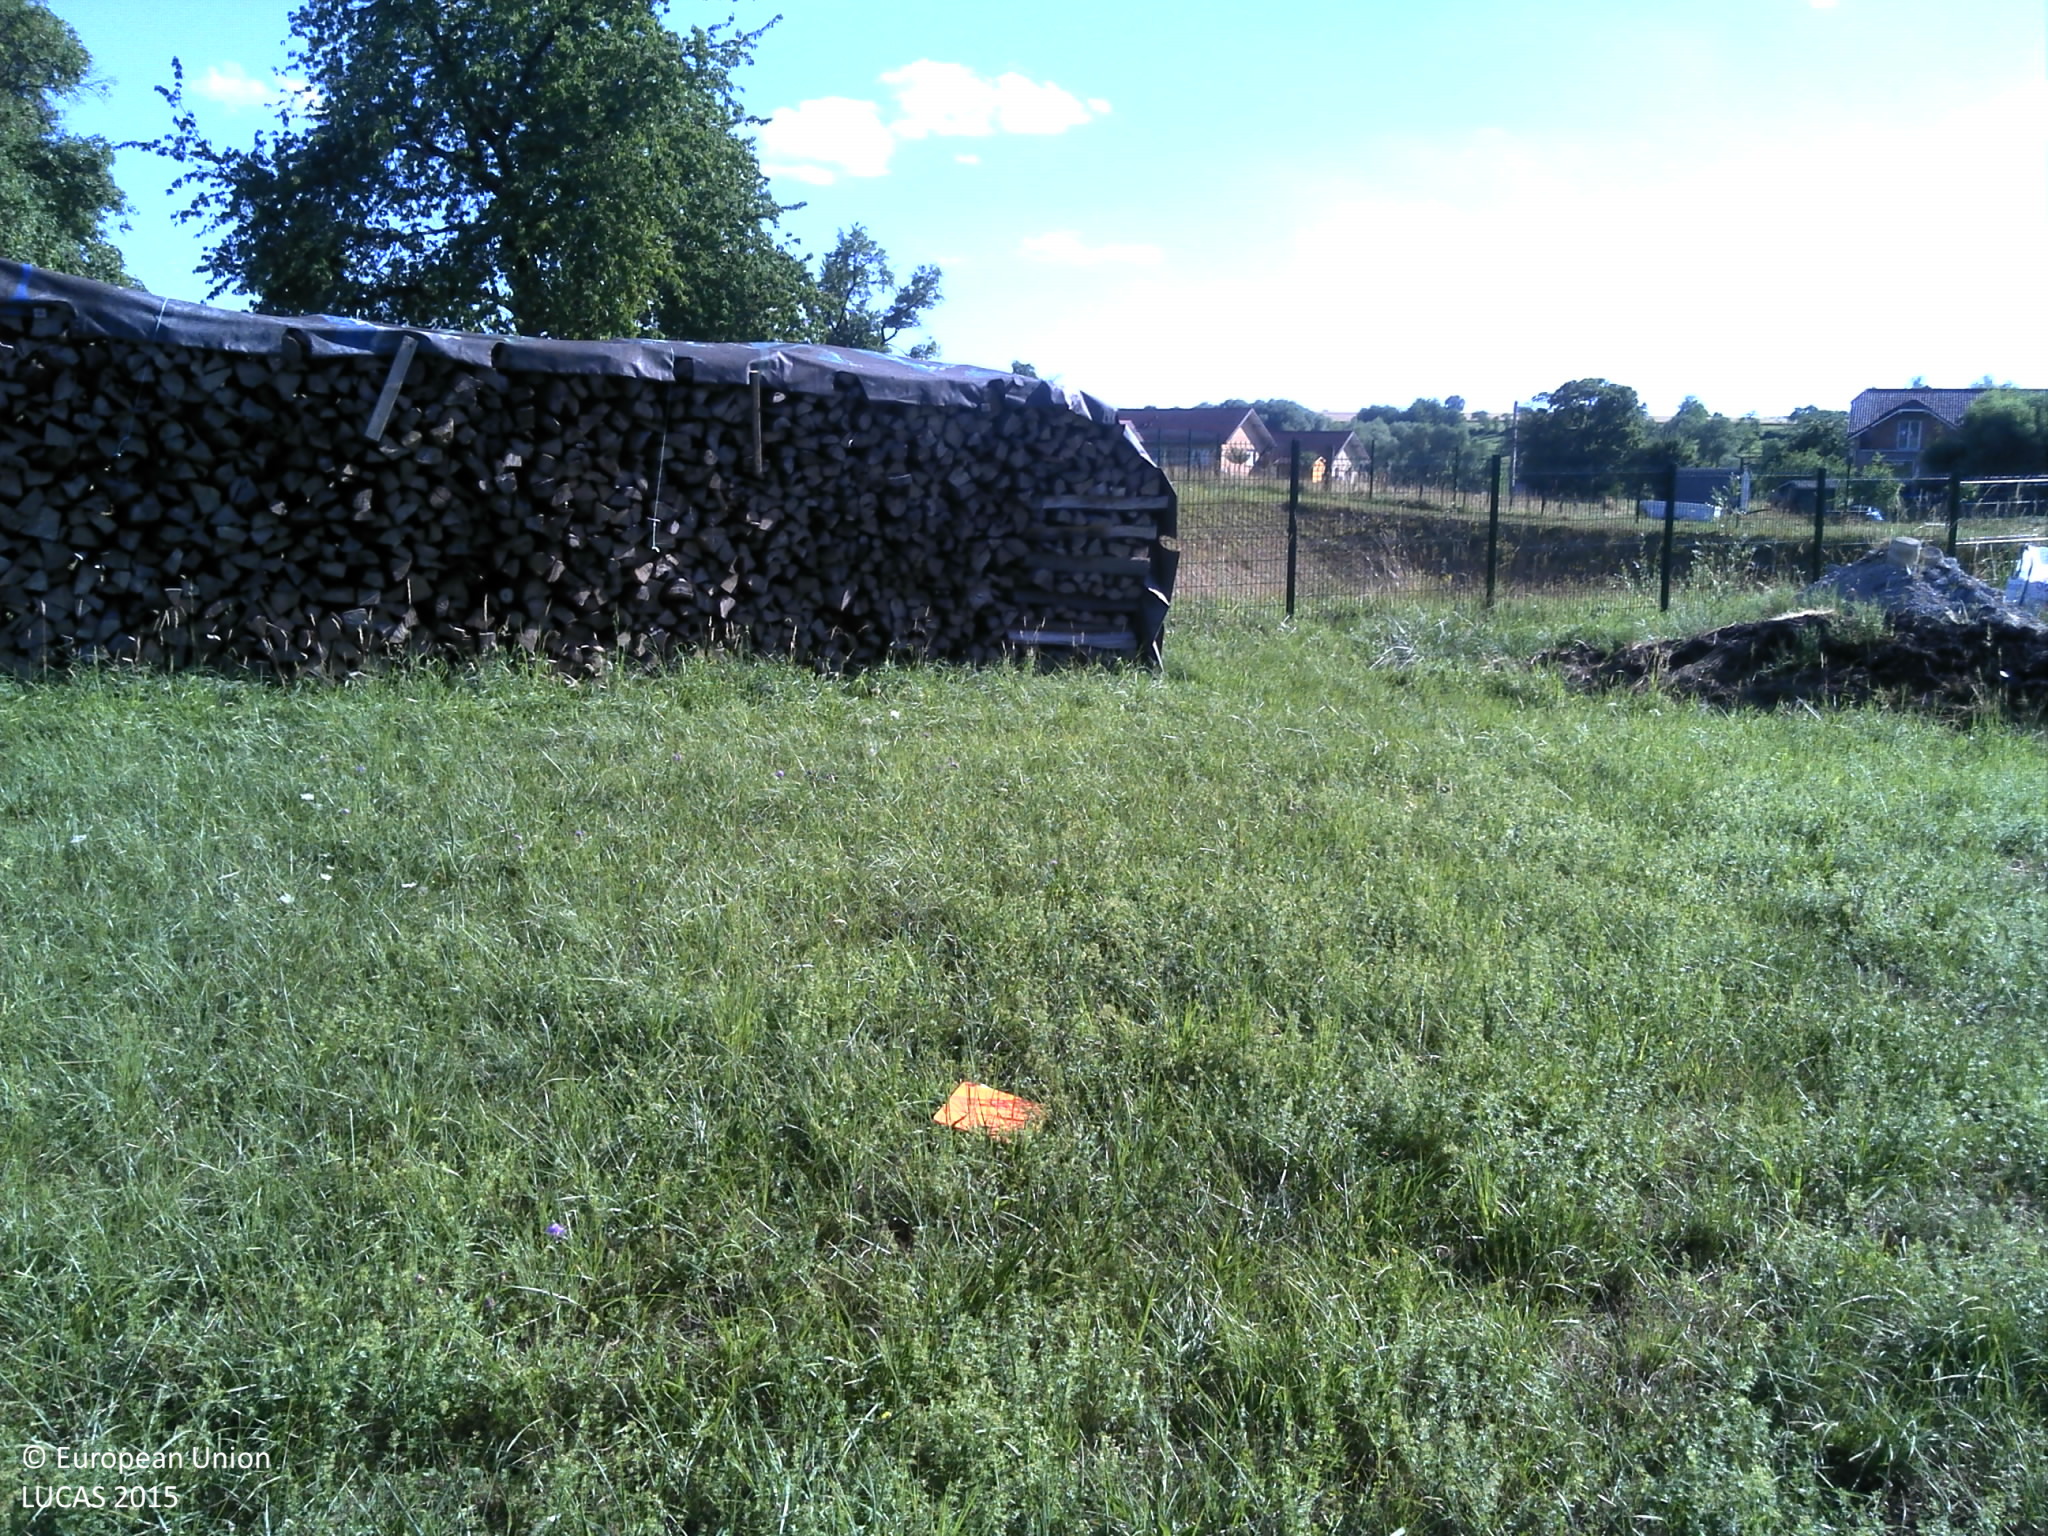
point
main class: Grassland
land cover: Grassland without tree/shrub cover
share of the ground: > 75 %
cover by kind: herbaceous plants 100 %
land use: Residential
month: July
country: FR
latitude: 49.0727
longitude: 7.3038
